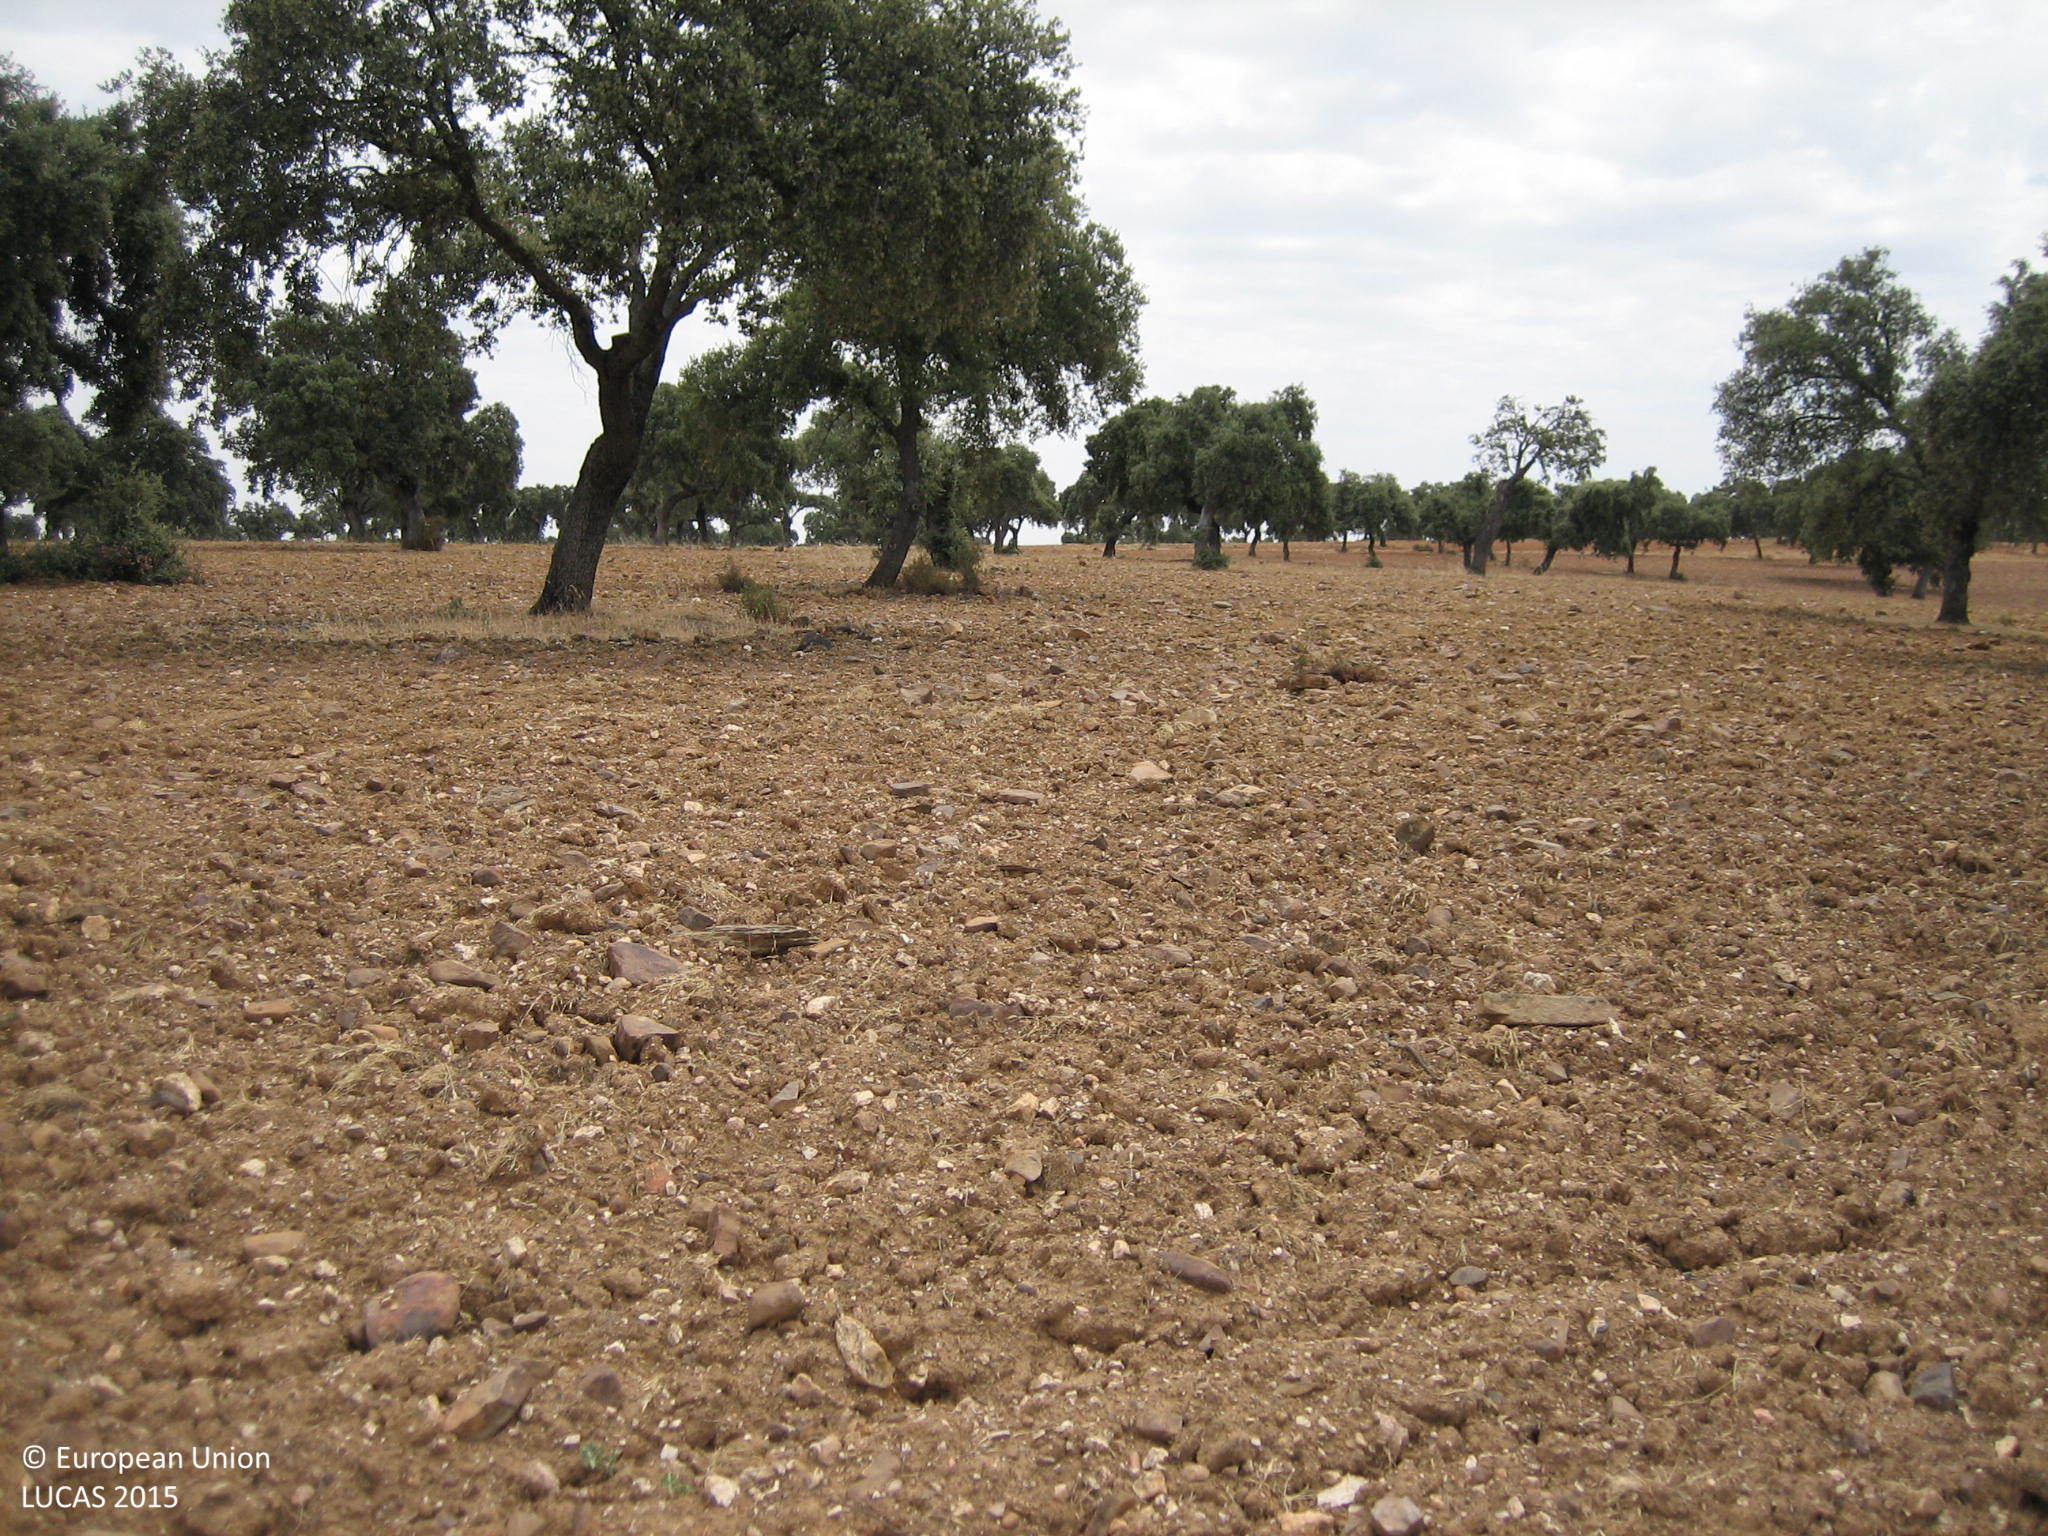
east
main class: Woodland
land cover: Broadleaved woodland
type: broadleaved evergreen forest
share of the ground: 10 - 25 %
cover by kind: unconsolidated bare surface 90 %, broadleaved forest trees 10 %
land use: Forestry
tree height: > 5 m
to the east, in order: Broadleaved woodland; Tracks; Broadleaved woodland
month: July
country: ES
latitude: 38.4798
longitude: -5.3591
